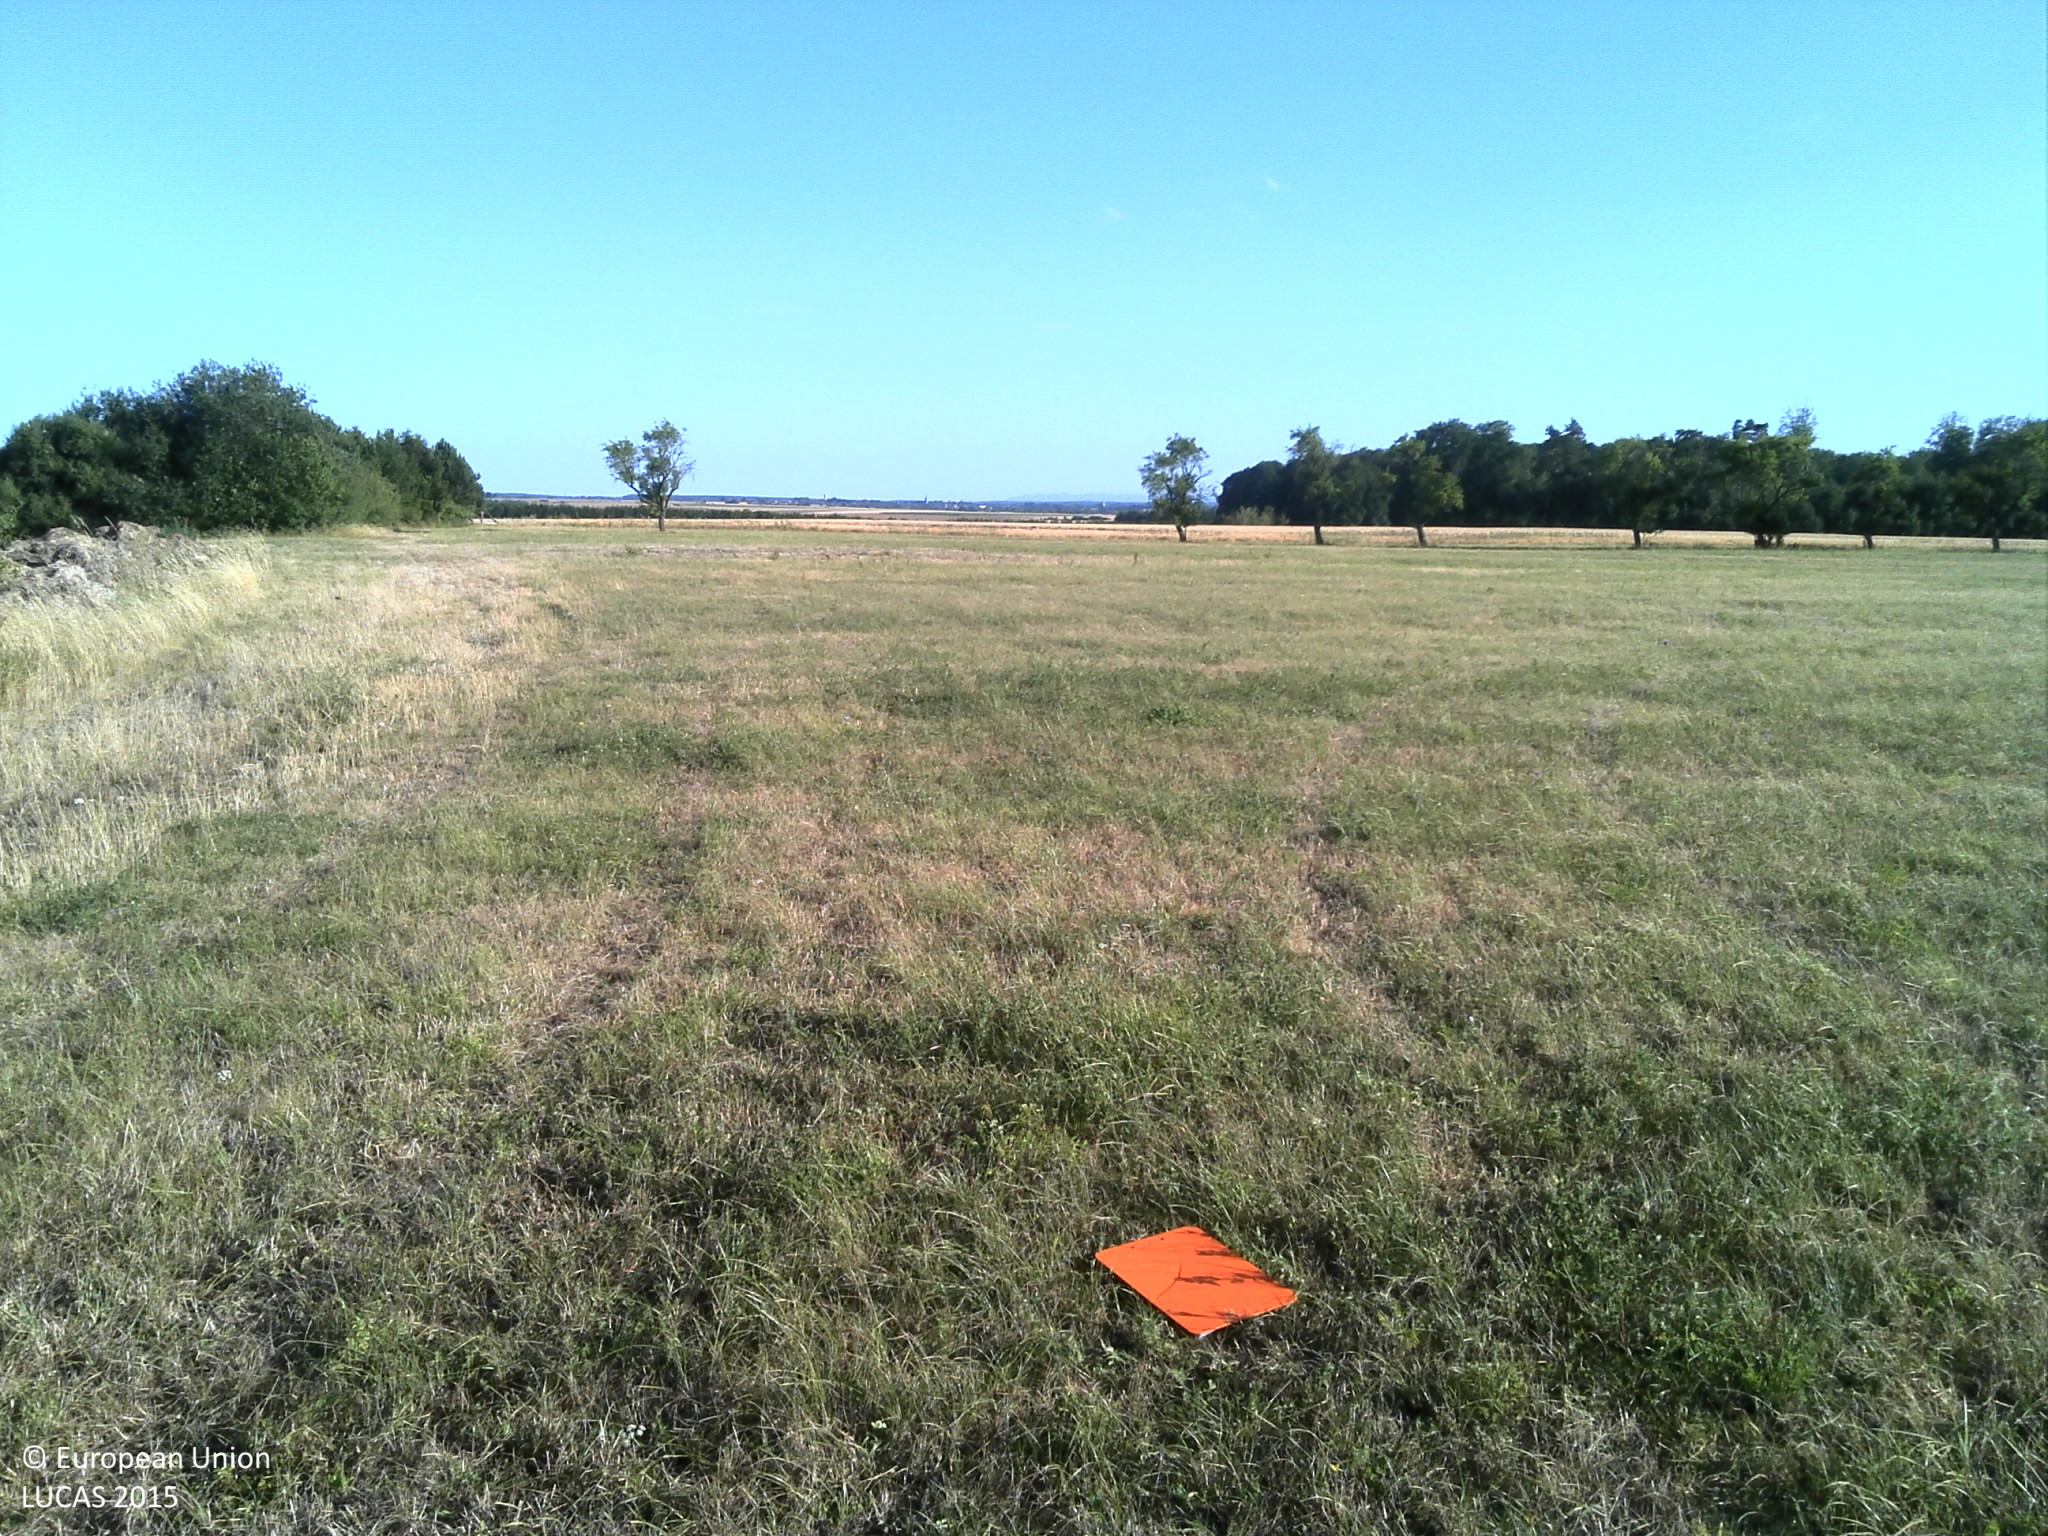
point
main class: Grassland
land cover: Grassland without tree/shrub cover
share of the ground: > 75 %
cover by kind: herbaceous plants 100 %
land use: Agriculture (excluding fallow land and kitchen gardens)
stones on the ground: < 10 %
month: July
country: FR
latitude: 49.1086
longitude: 7.3018
